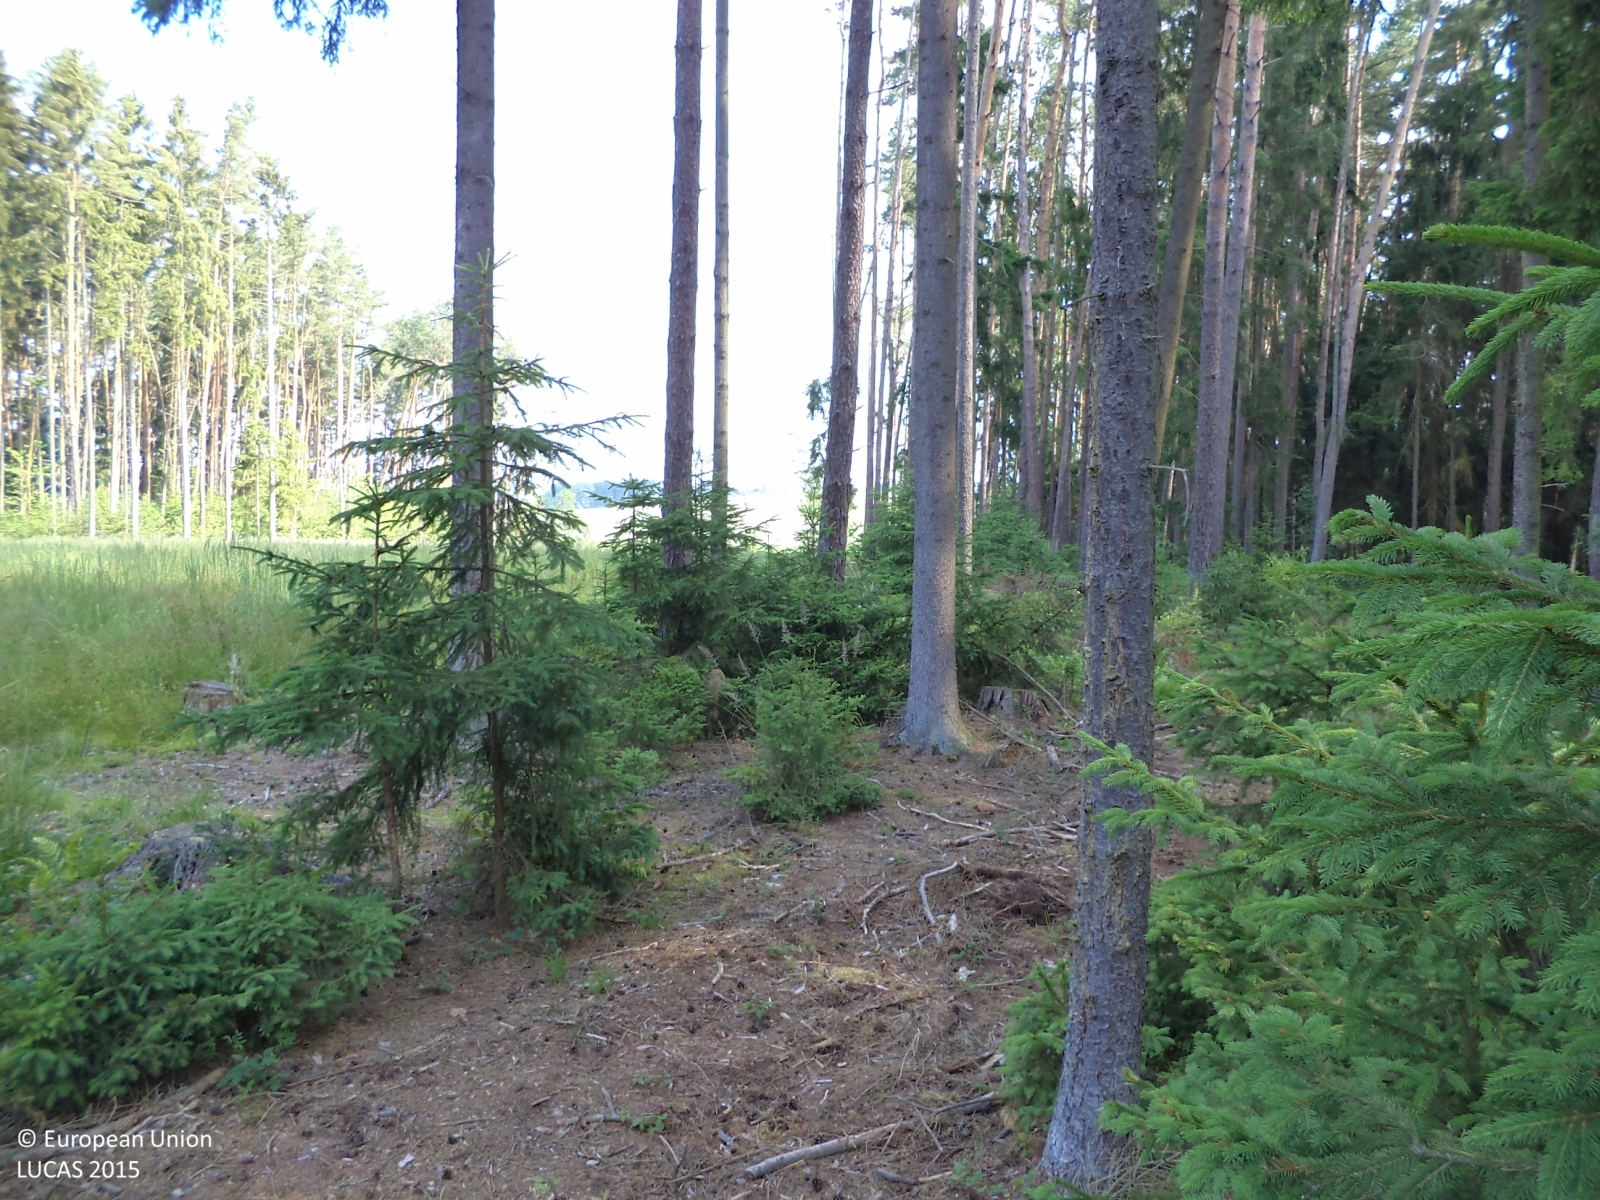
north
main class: Woodland
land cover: Pine dominated coniferous woodland
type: hemiboreal forest and nemoral coniferous forest and mixed broadleaved-coniferous forest
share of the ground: > 75 %
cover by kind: coniferous forest trees 90 %, herbaceous plants 10 %
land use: Forestry
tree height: > 5 m
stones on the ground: < 10 %
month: July
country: CZ
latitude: 49.3780
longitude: 14.4226
